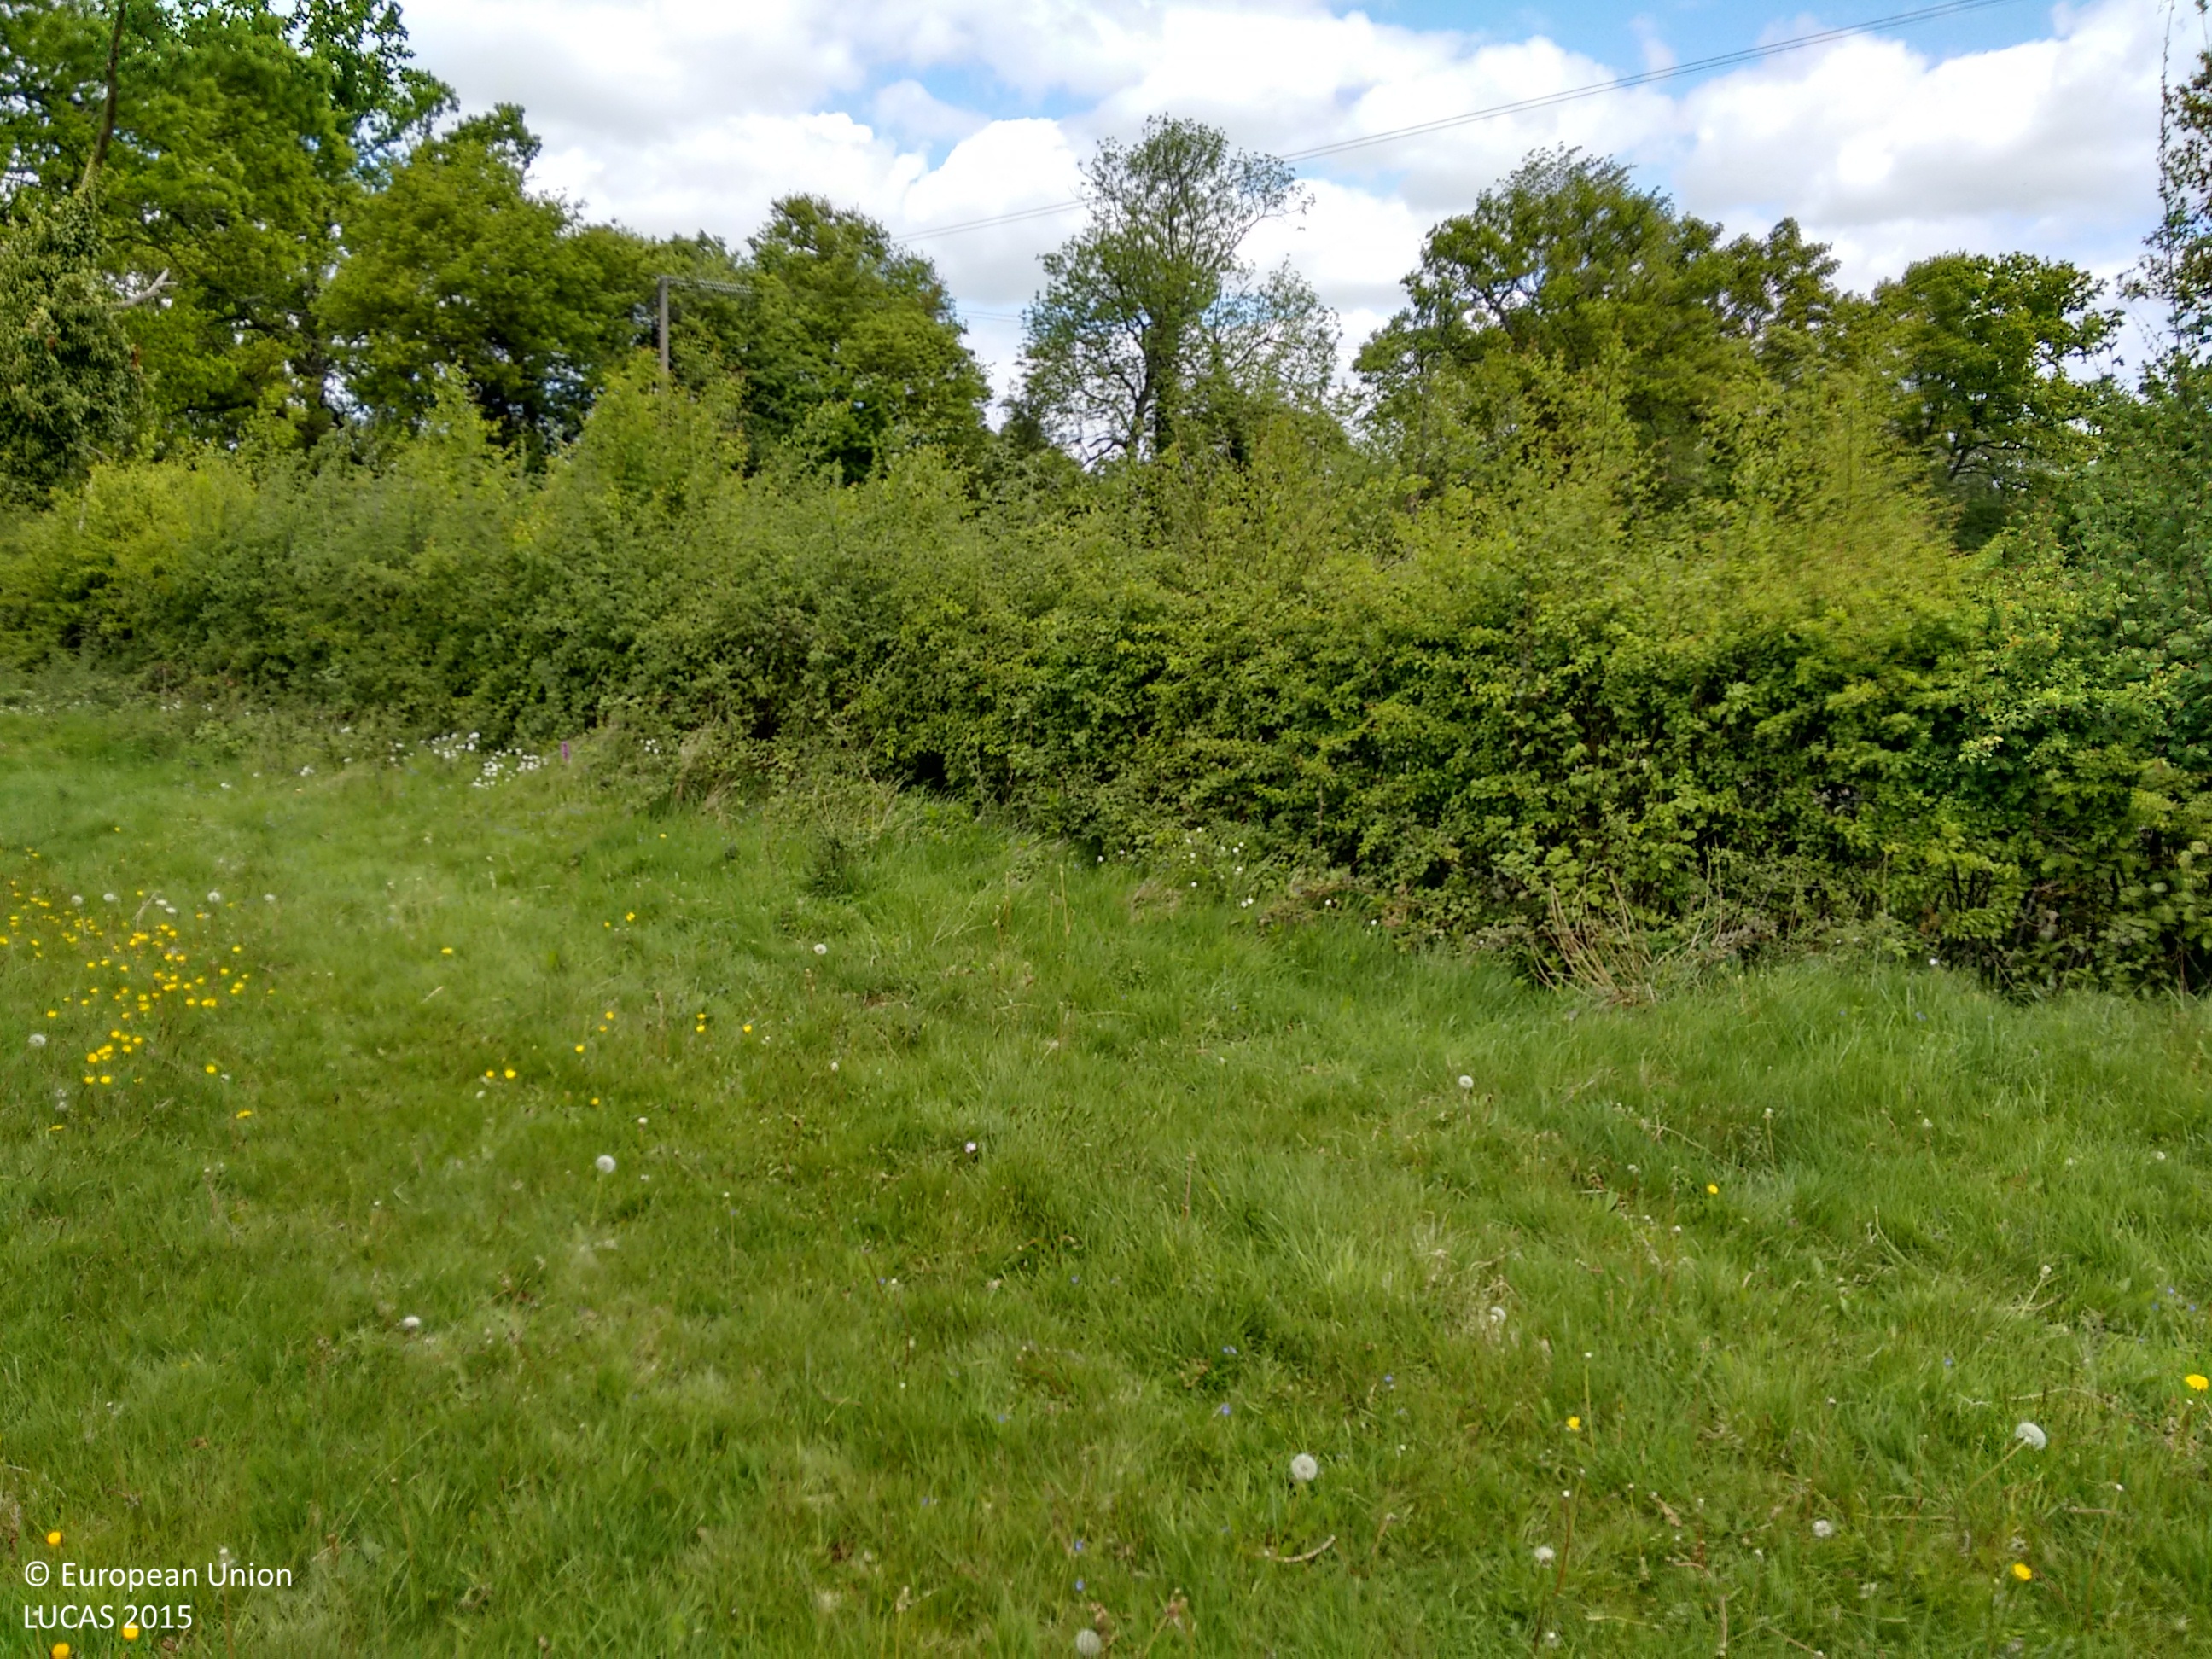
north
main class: Grassland
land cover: Grassland without tree/shrub cover
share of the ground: > 75 %
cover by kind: herbaceous plants 100 %
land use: Agriculture (excluding fallow land and kitchen gardens)
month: May
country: GB
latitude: 51.3399
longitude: -1.1719
